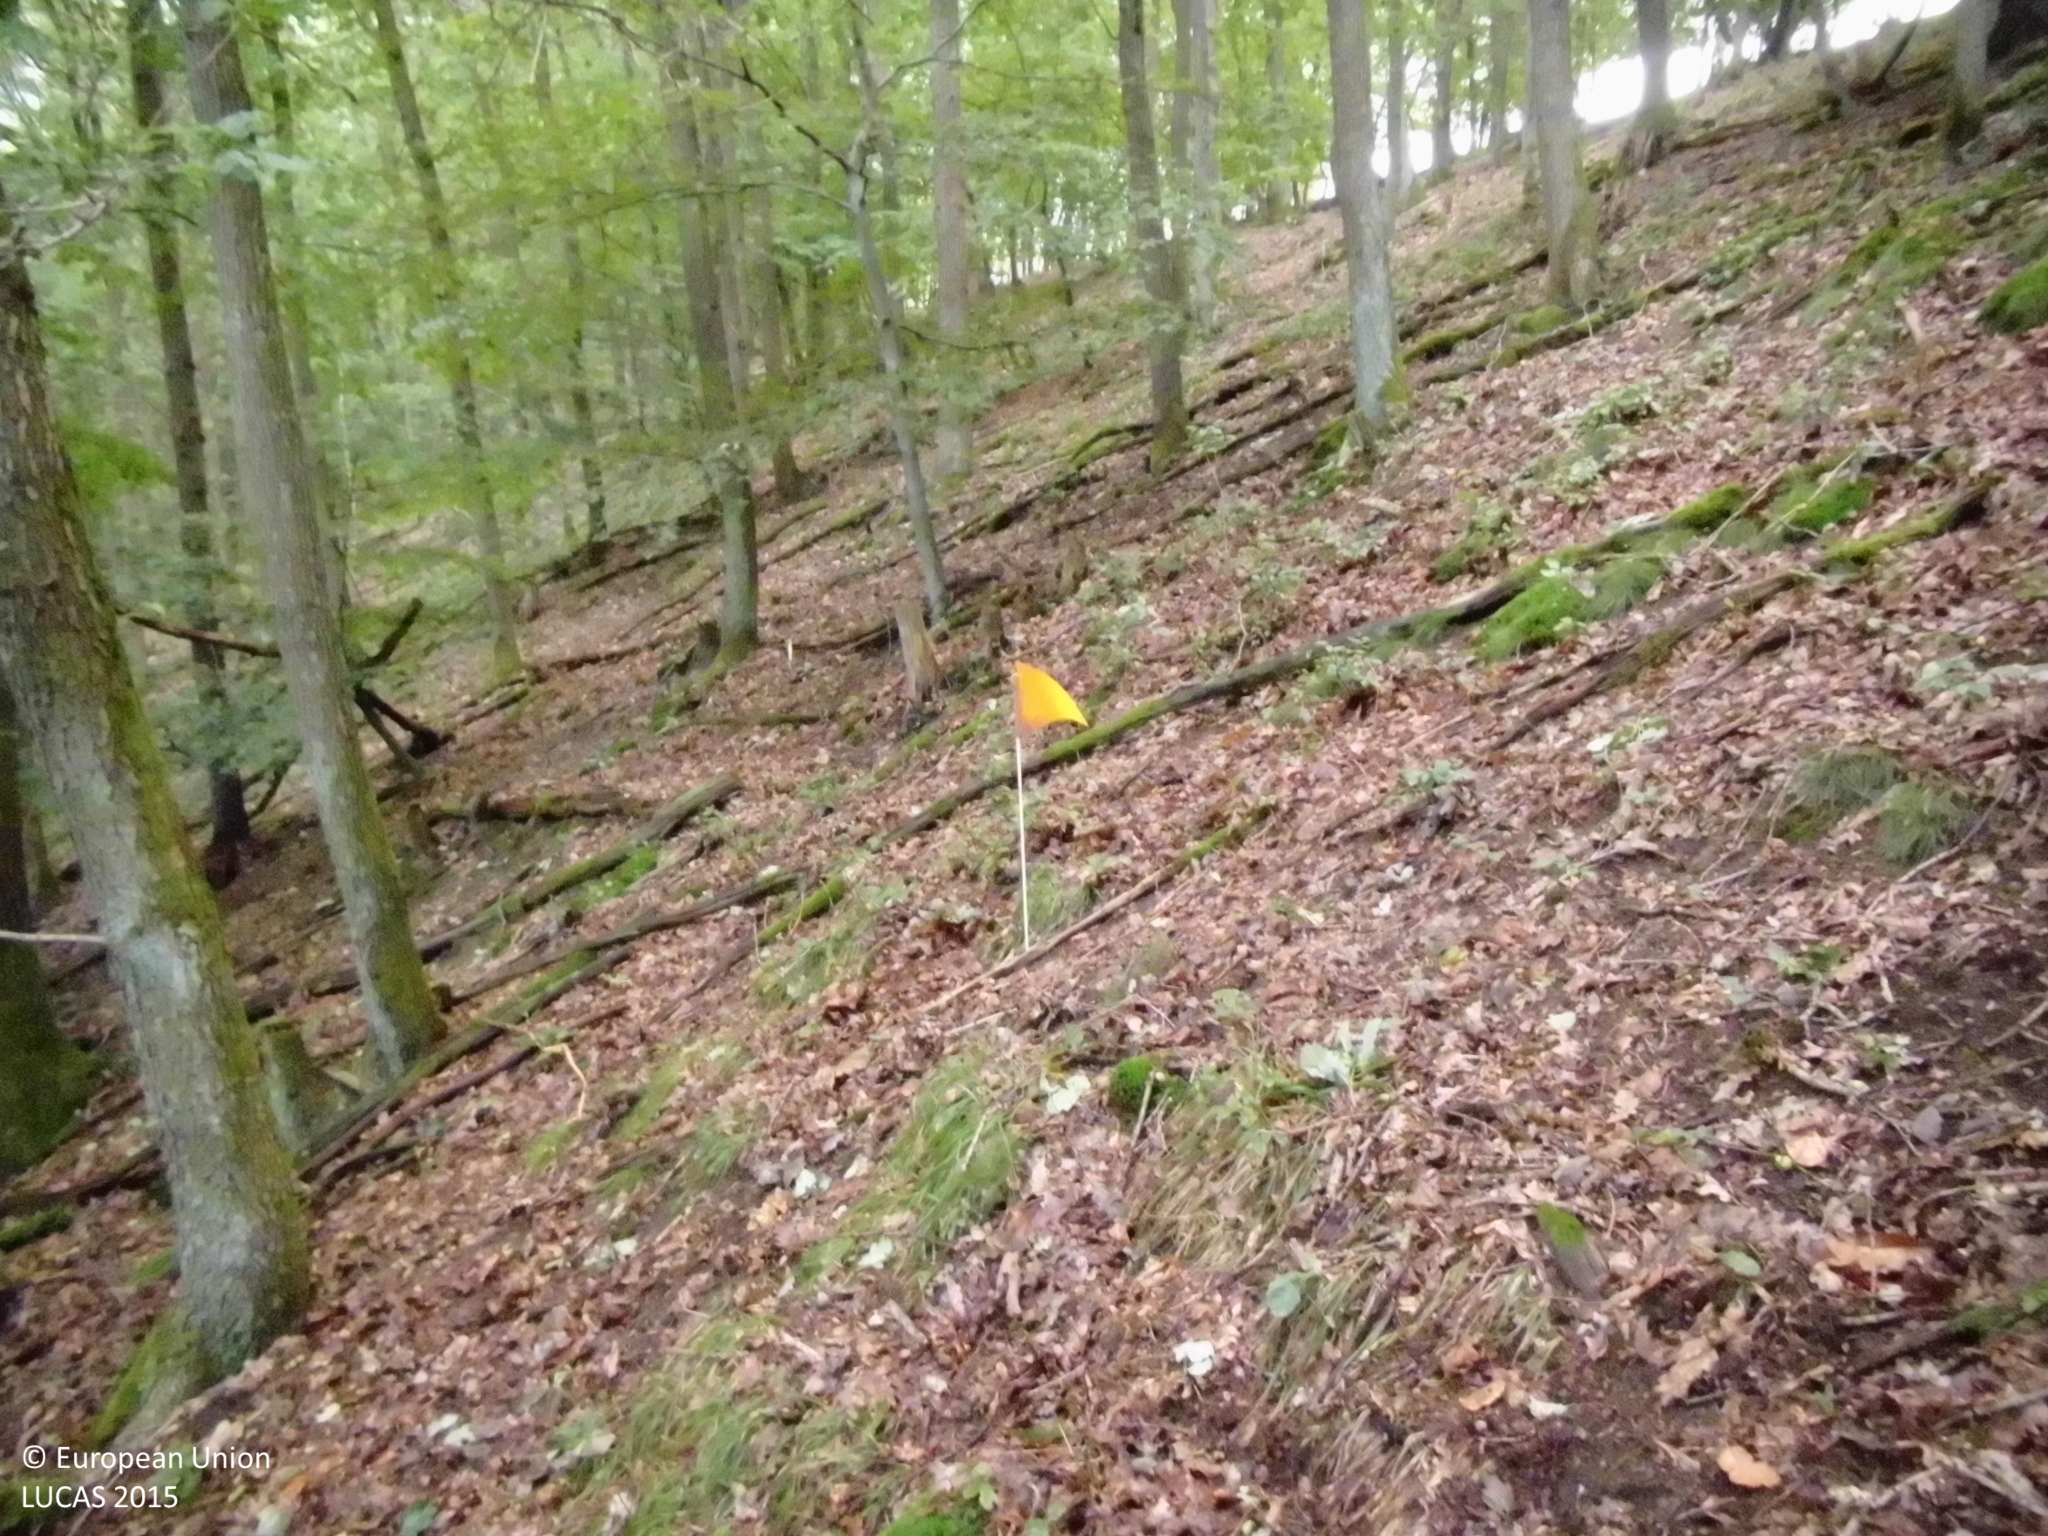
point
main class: Woodland
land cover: Broadleaved woodland
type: mesophytic deciduous forest
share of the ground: > 75 %
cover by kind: broadleaved forest trees 100 %
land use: Forestry
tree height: > 5 m
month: September
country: DE
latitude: 50.5874
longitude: 7.4437
